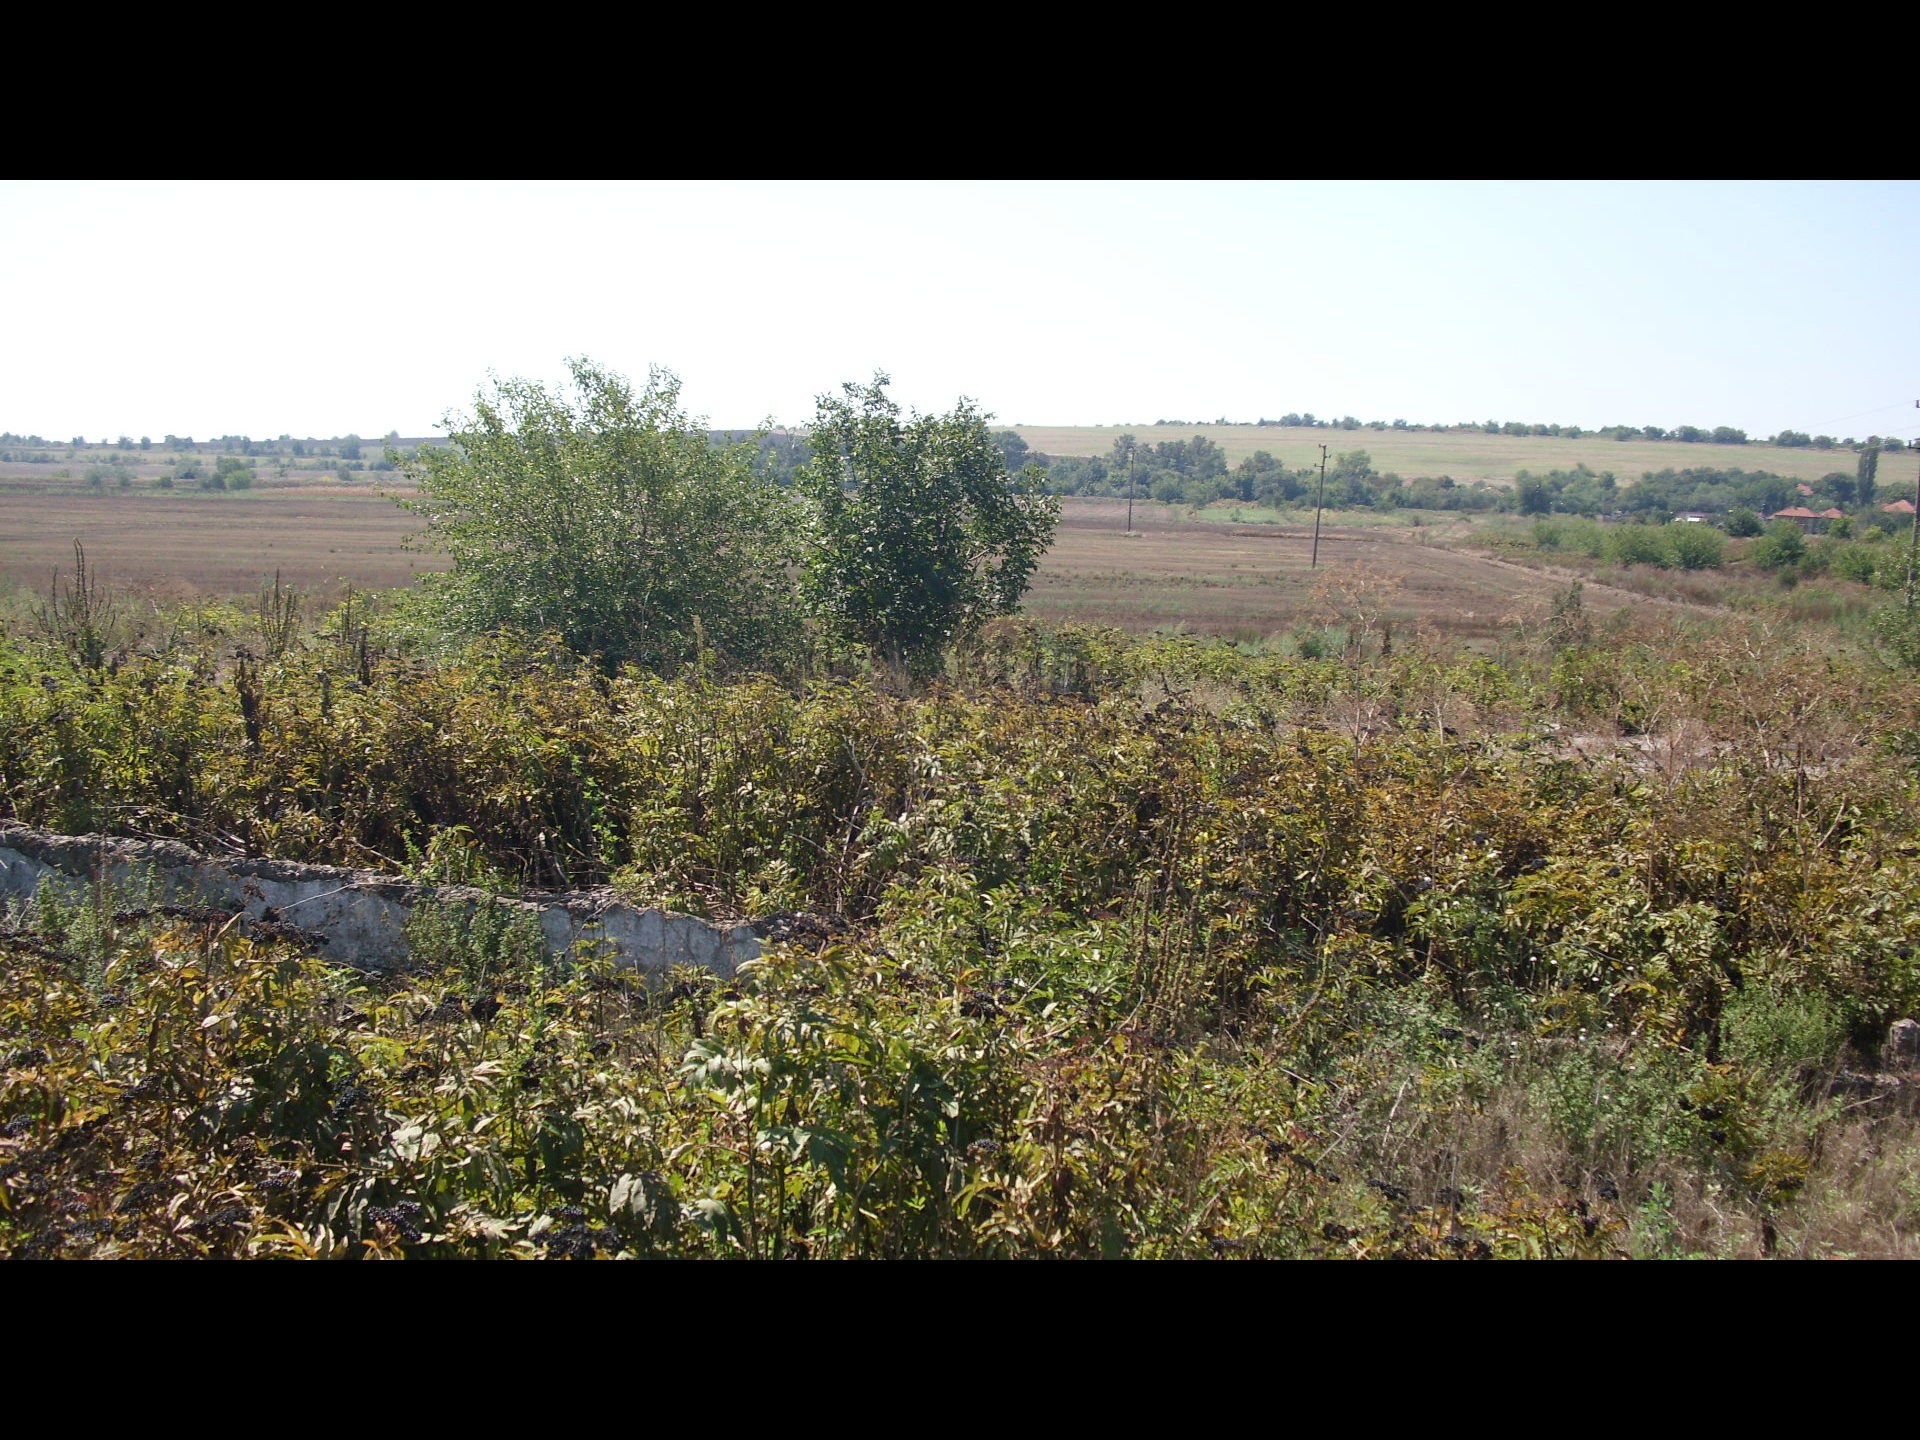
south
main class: Grassland
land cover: Grassland with sparse tree/shrub cover
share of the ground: > 75 %
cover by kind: herbaceous plants 85 %, shrubs 10 %, broadleaved forest trees 5 %
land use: Abandoned areas
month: August
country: BG
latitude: 44.0930
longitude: 22.8679
